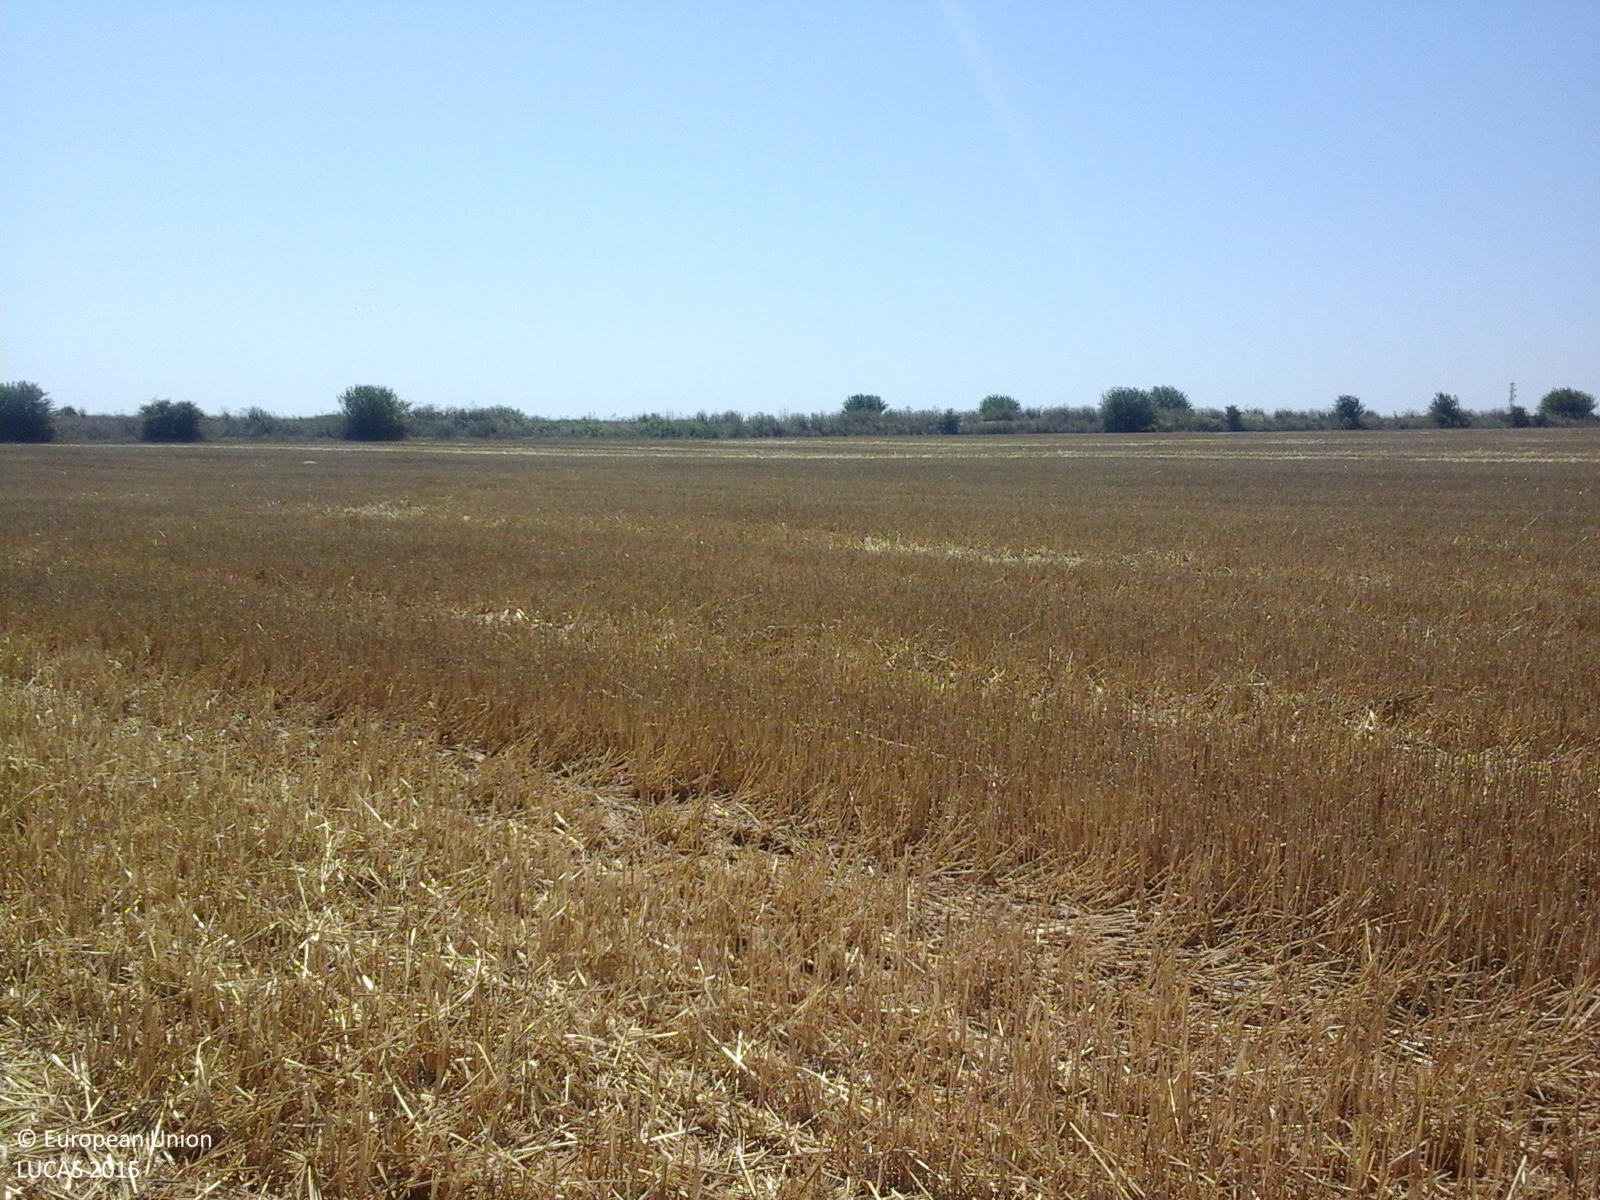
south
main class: Cropland
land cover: Common wheat
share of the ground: > 75 %
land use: Agriculture (excluding fallow land and kitchen gardens)
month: August
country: RO
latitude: 44.1971
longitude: 28.5265
